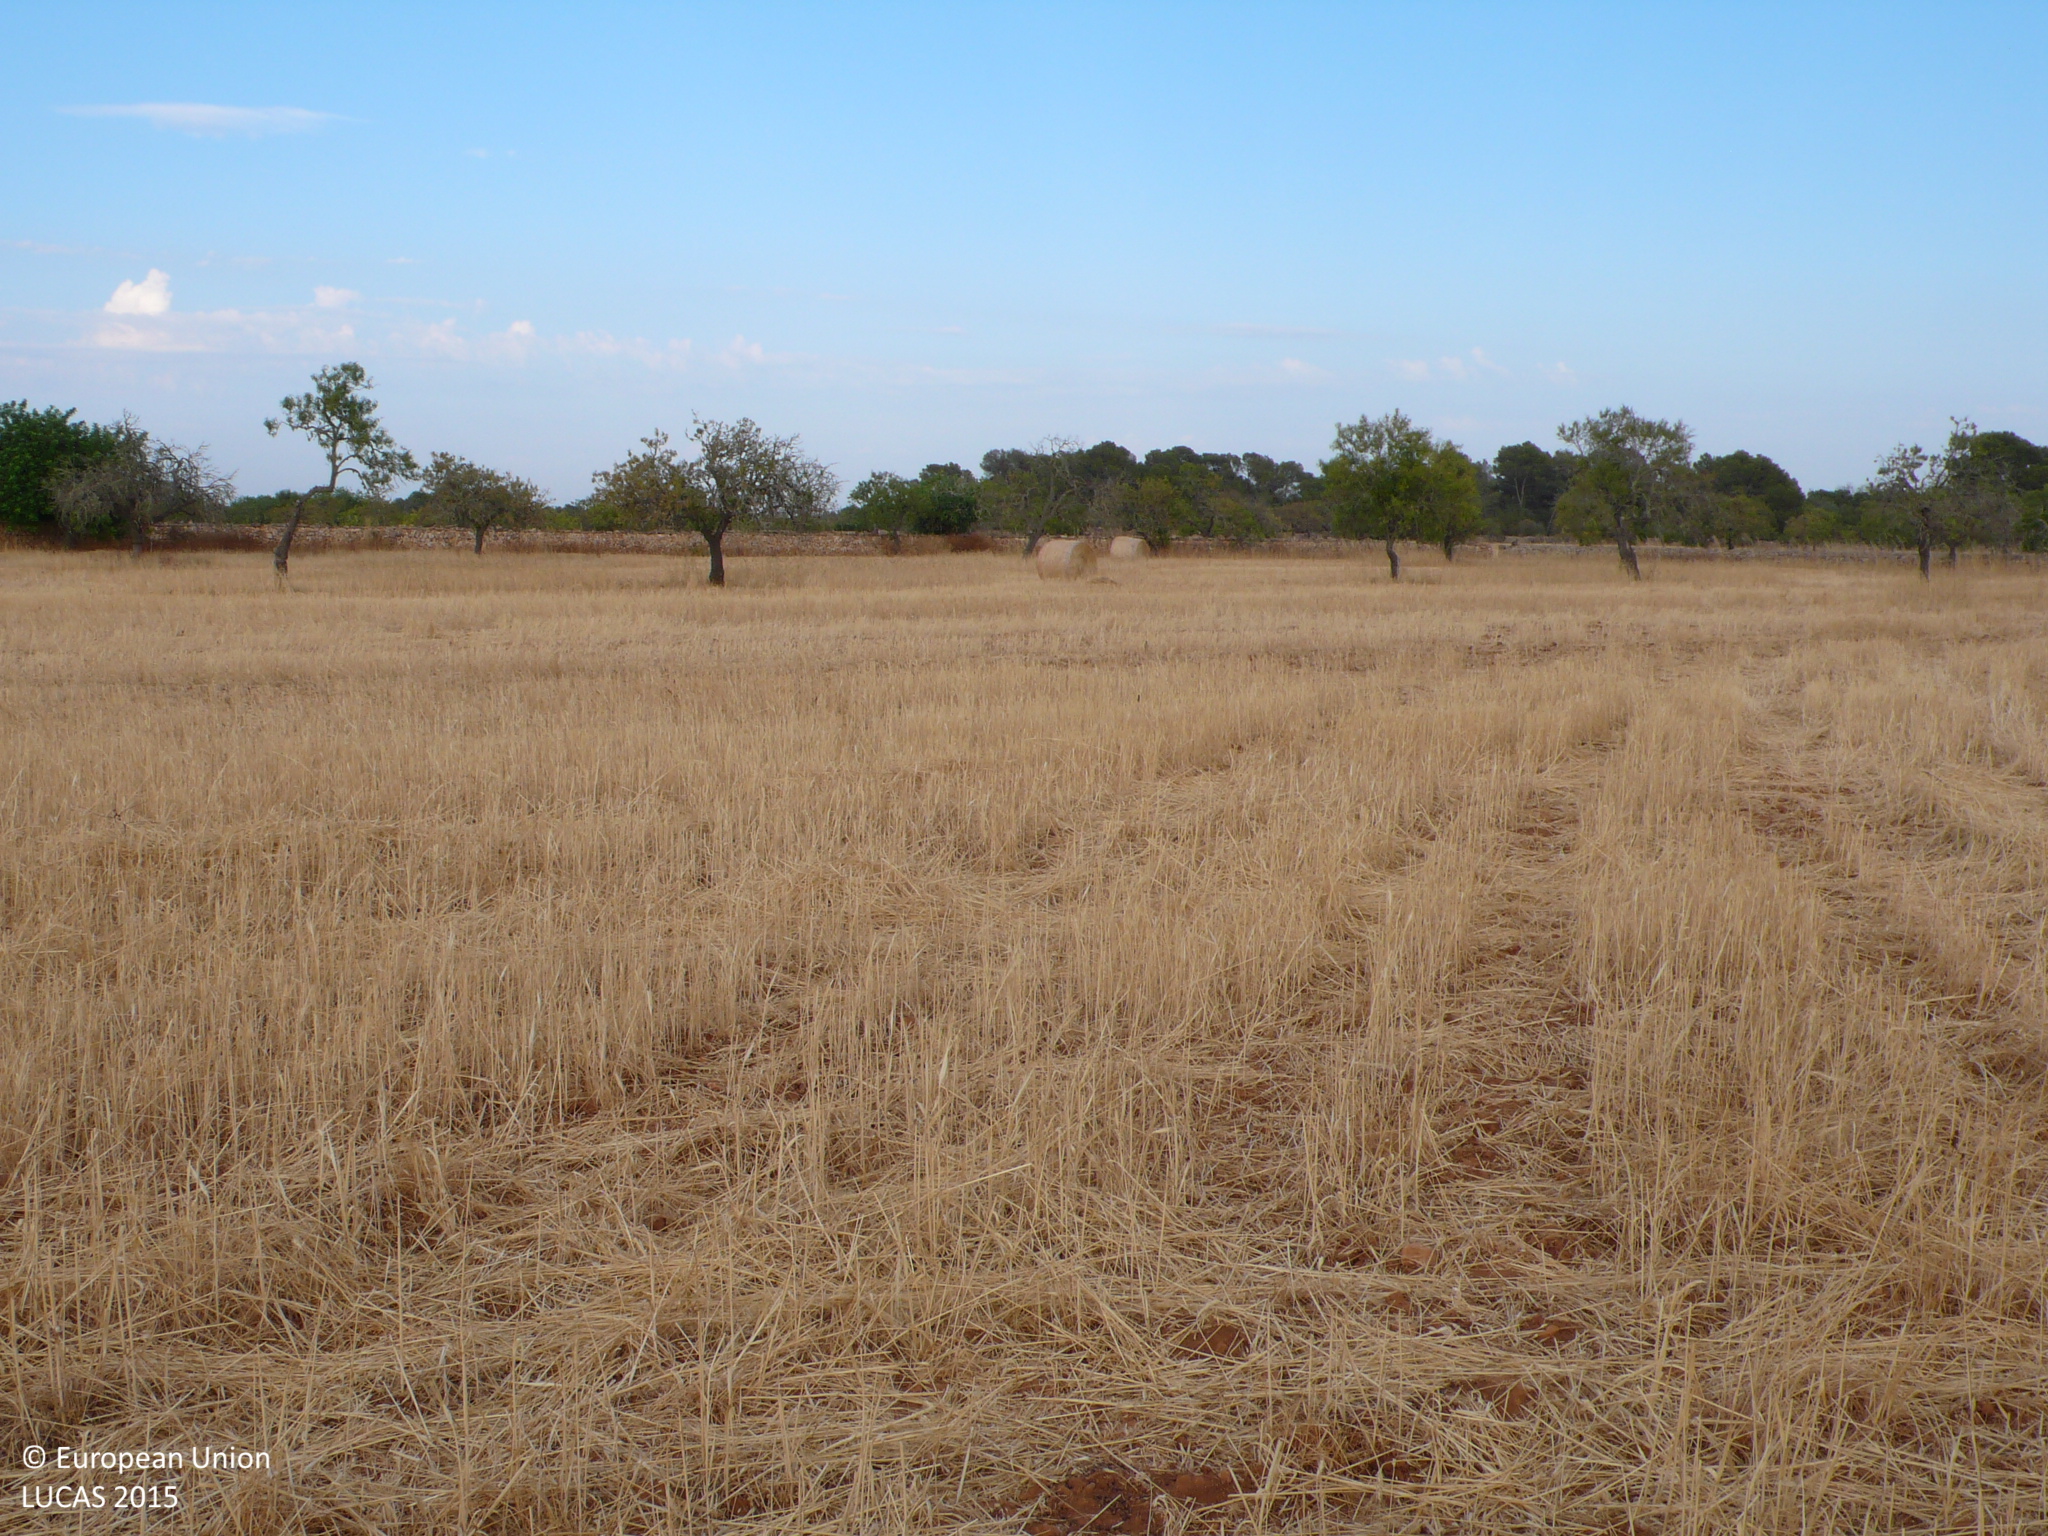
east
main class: Cropland
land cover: Common wheat
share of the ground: < 10 %
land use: Agriculture (excluding fallow land and kitchen gardens)
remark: Harvested field
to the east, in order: Common wheat; Nuts trees; Dry stone walls; Nuts trees; Dry pulses; Dry stone walls; Tracks; Dry stone walls; Barley
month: July
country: ES
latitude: 39.4765
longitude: 2.8119
